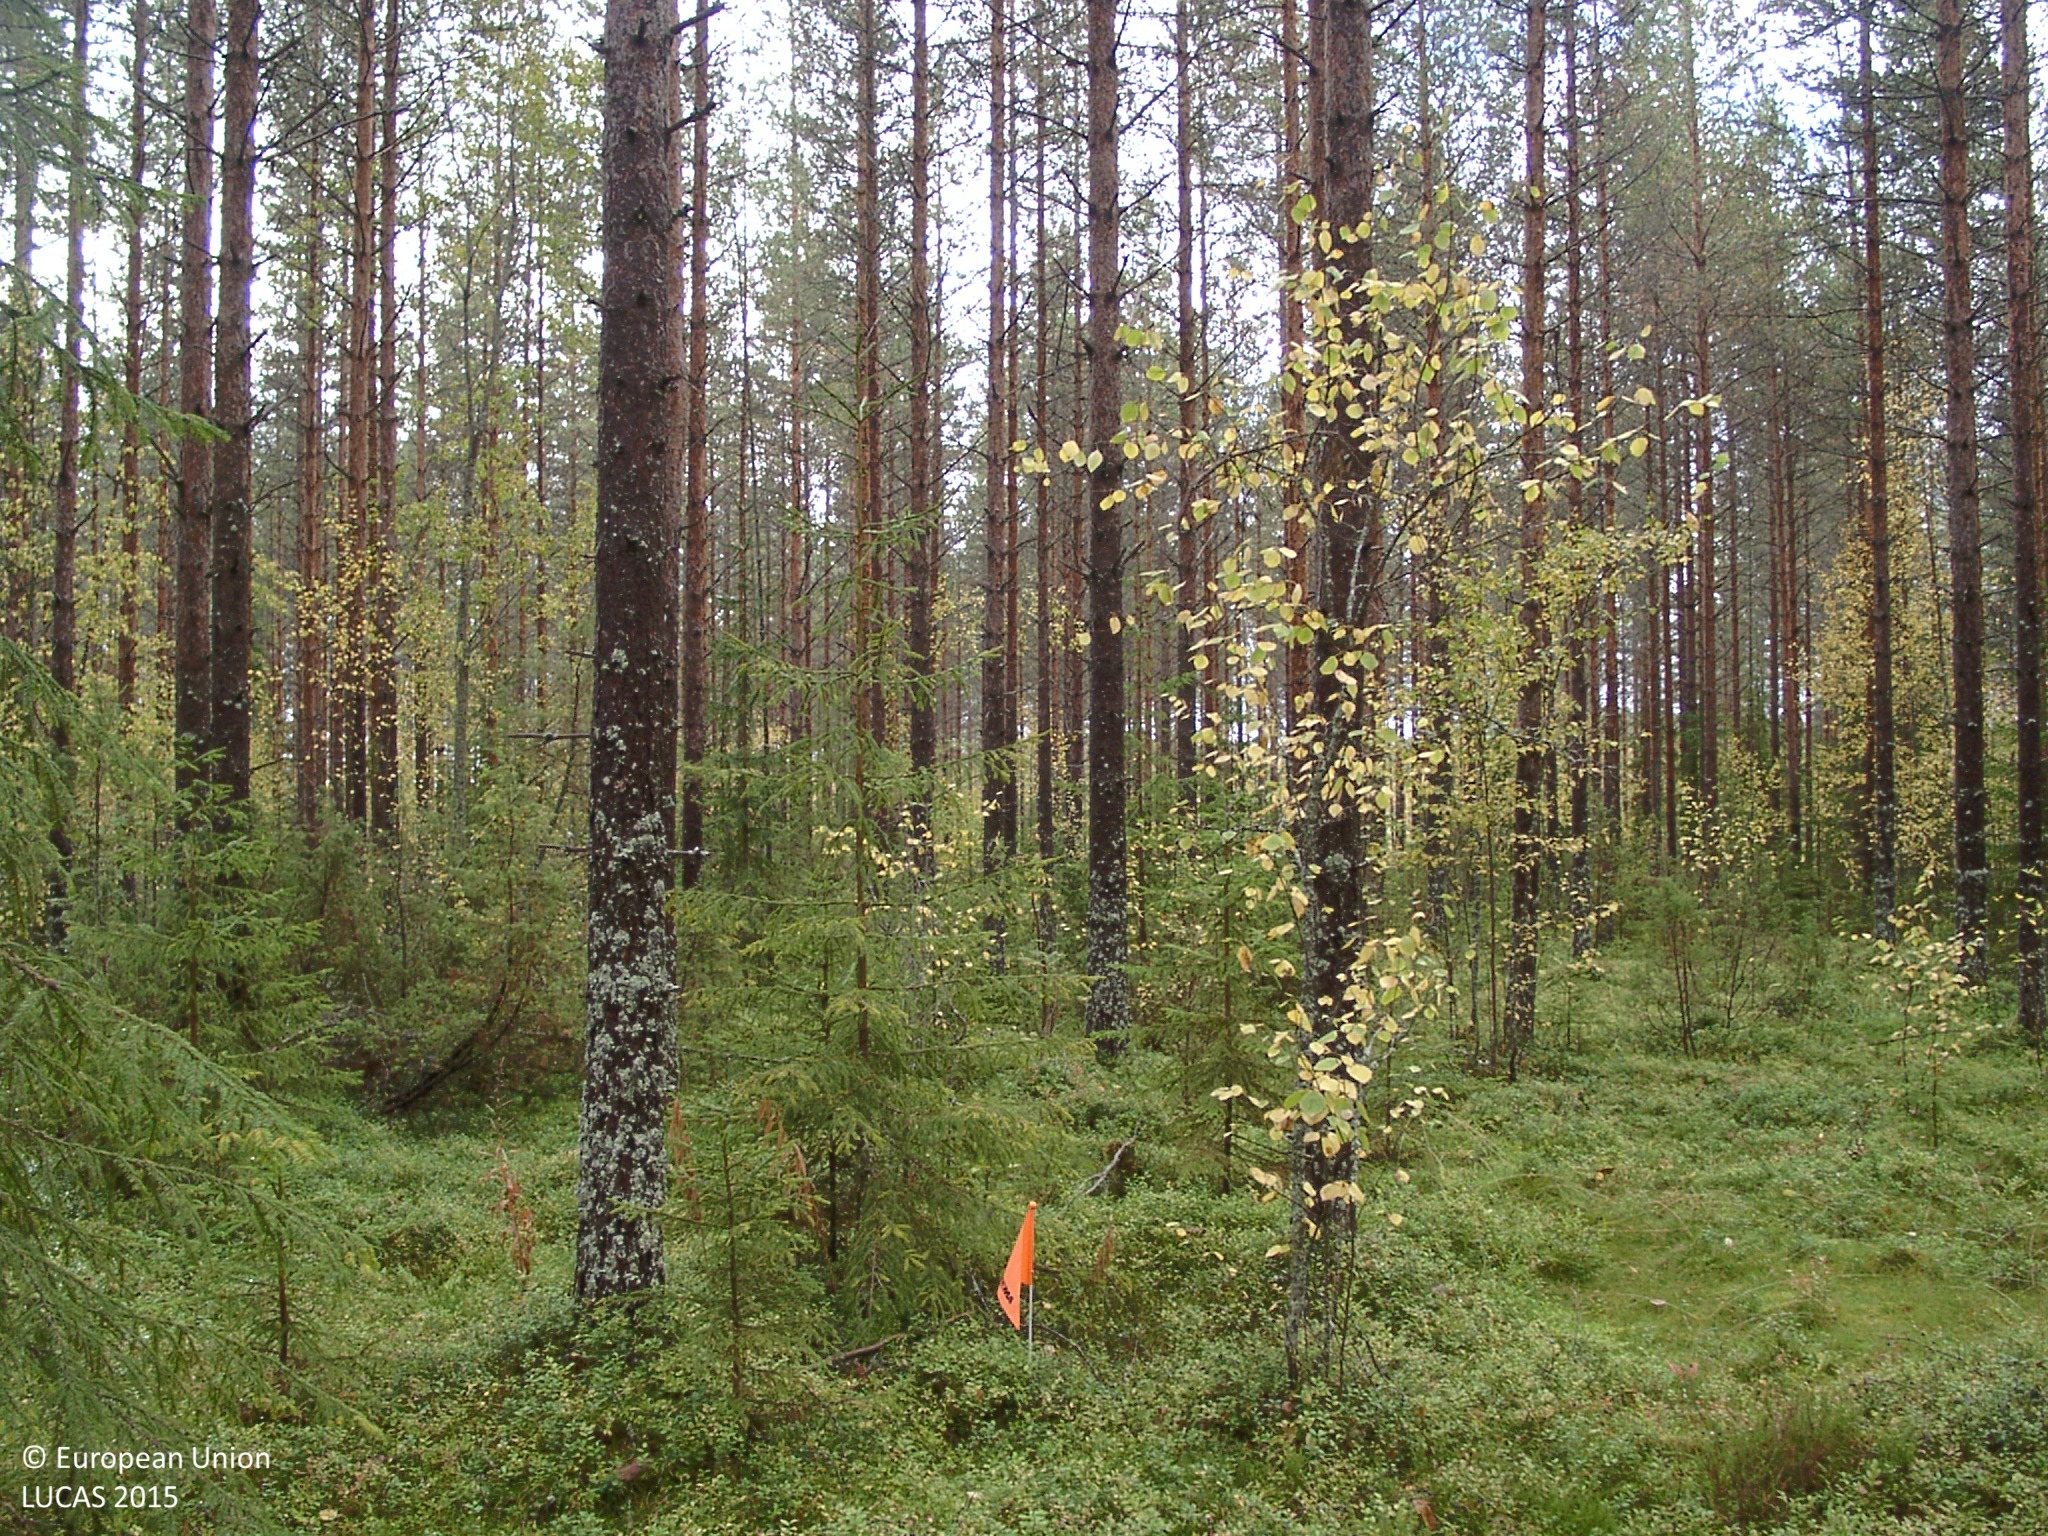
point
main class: Woodland
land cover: Pine dominated coniferous woodland
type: boreal forest
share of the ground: 50 - 75 %
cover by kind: coniferous forest trees 65 %, shrubs 30 %, broadleaved forest trees 5 %
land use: Forestry
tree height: > 5 m
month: September
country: FI
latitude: 62.4987
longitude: 25.1874
